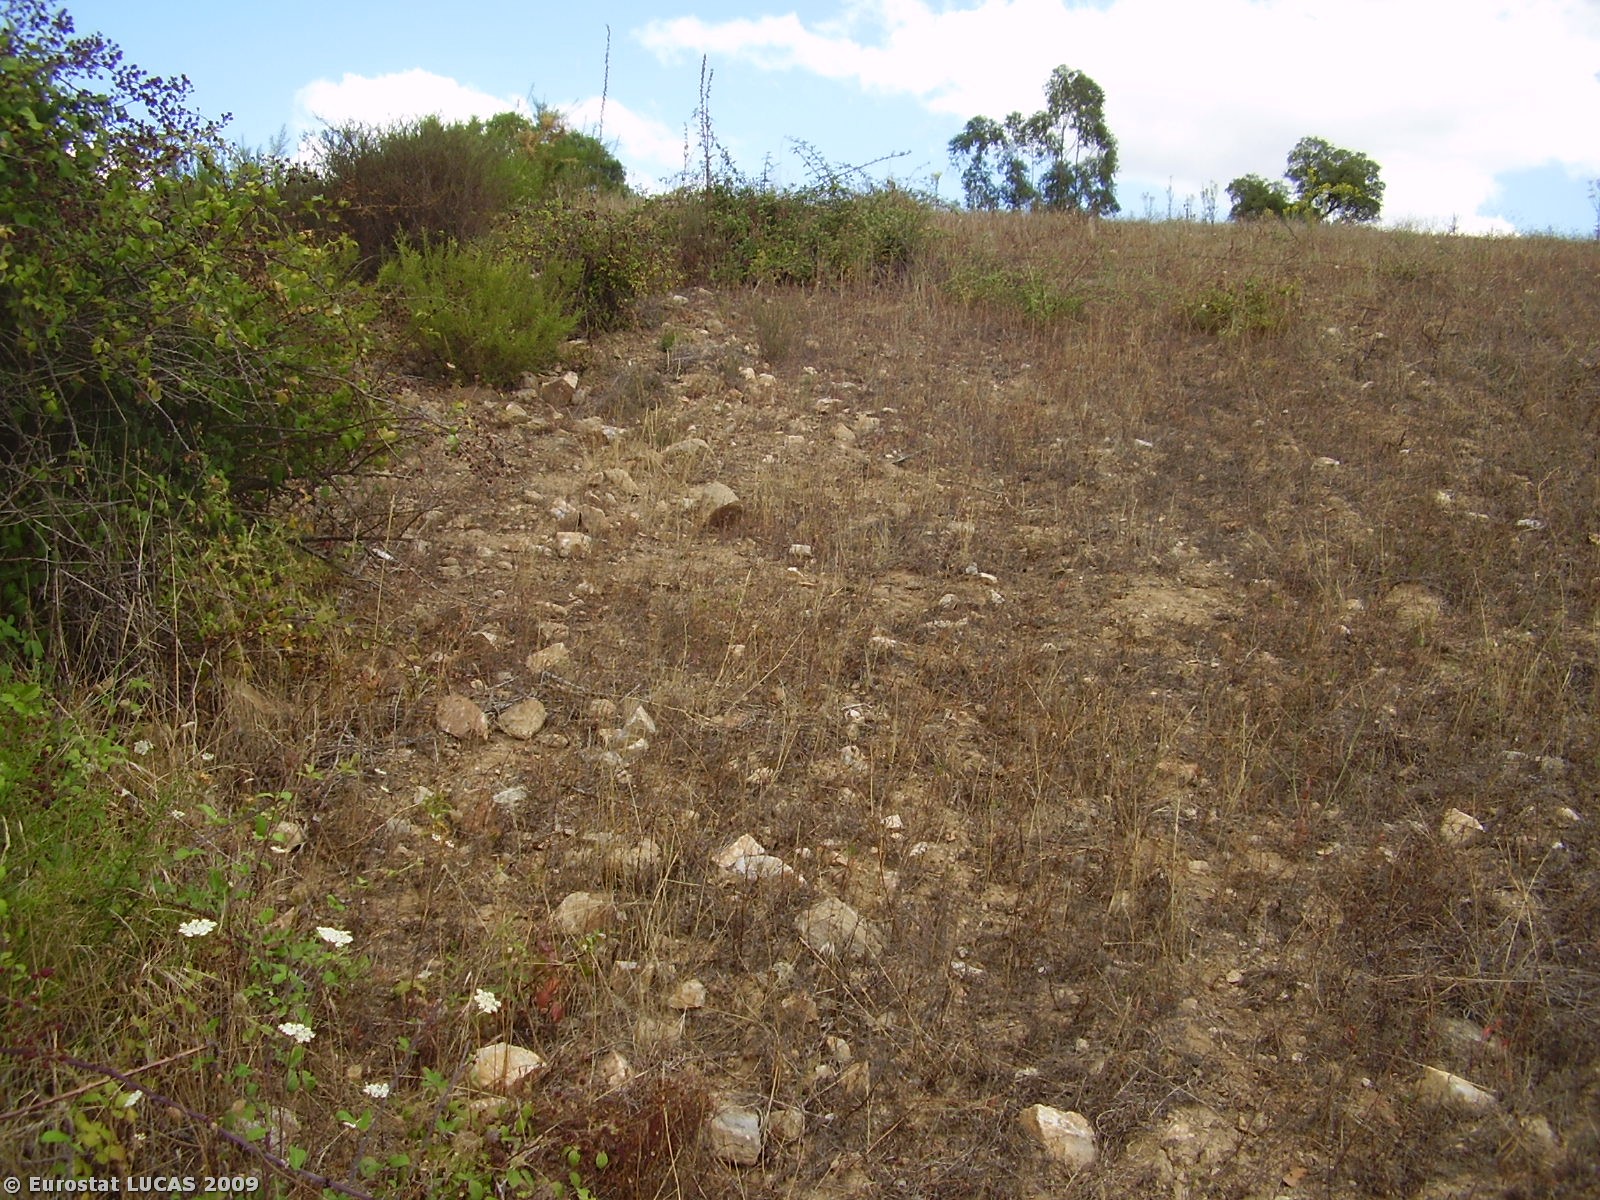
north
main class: Grassland
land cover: Grassland with sparse tree/shrub cover
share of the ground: 50 - 75 %
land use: Fallow land
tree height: > 5 m
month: July
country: PT
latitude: 39.5331
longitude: -8.3707
